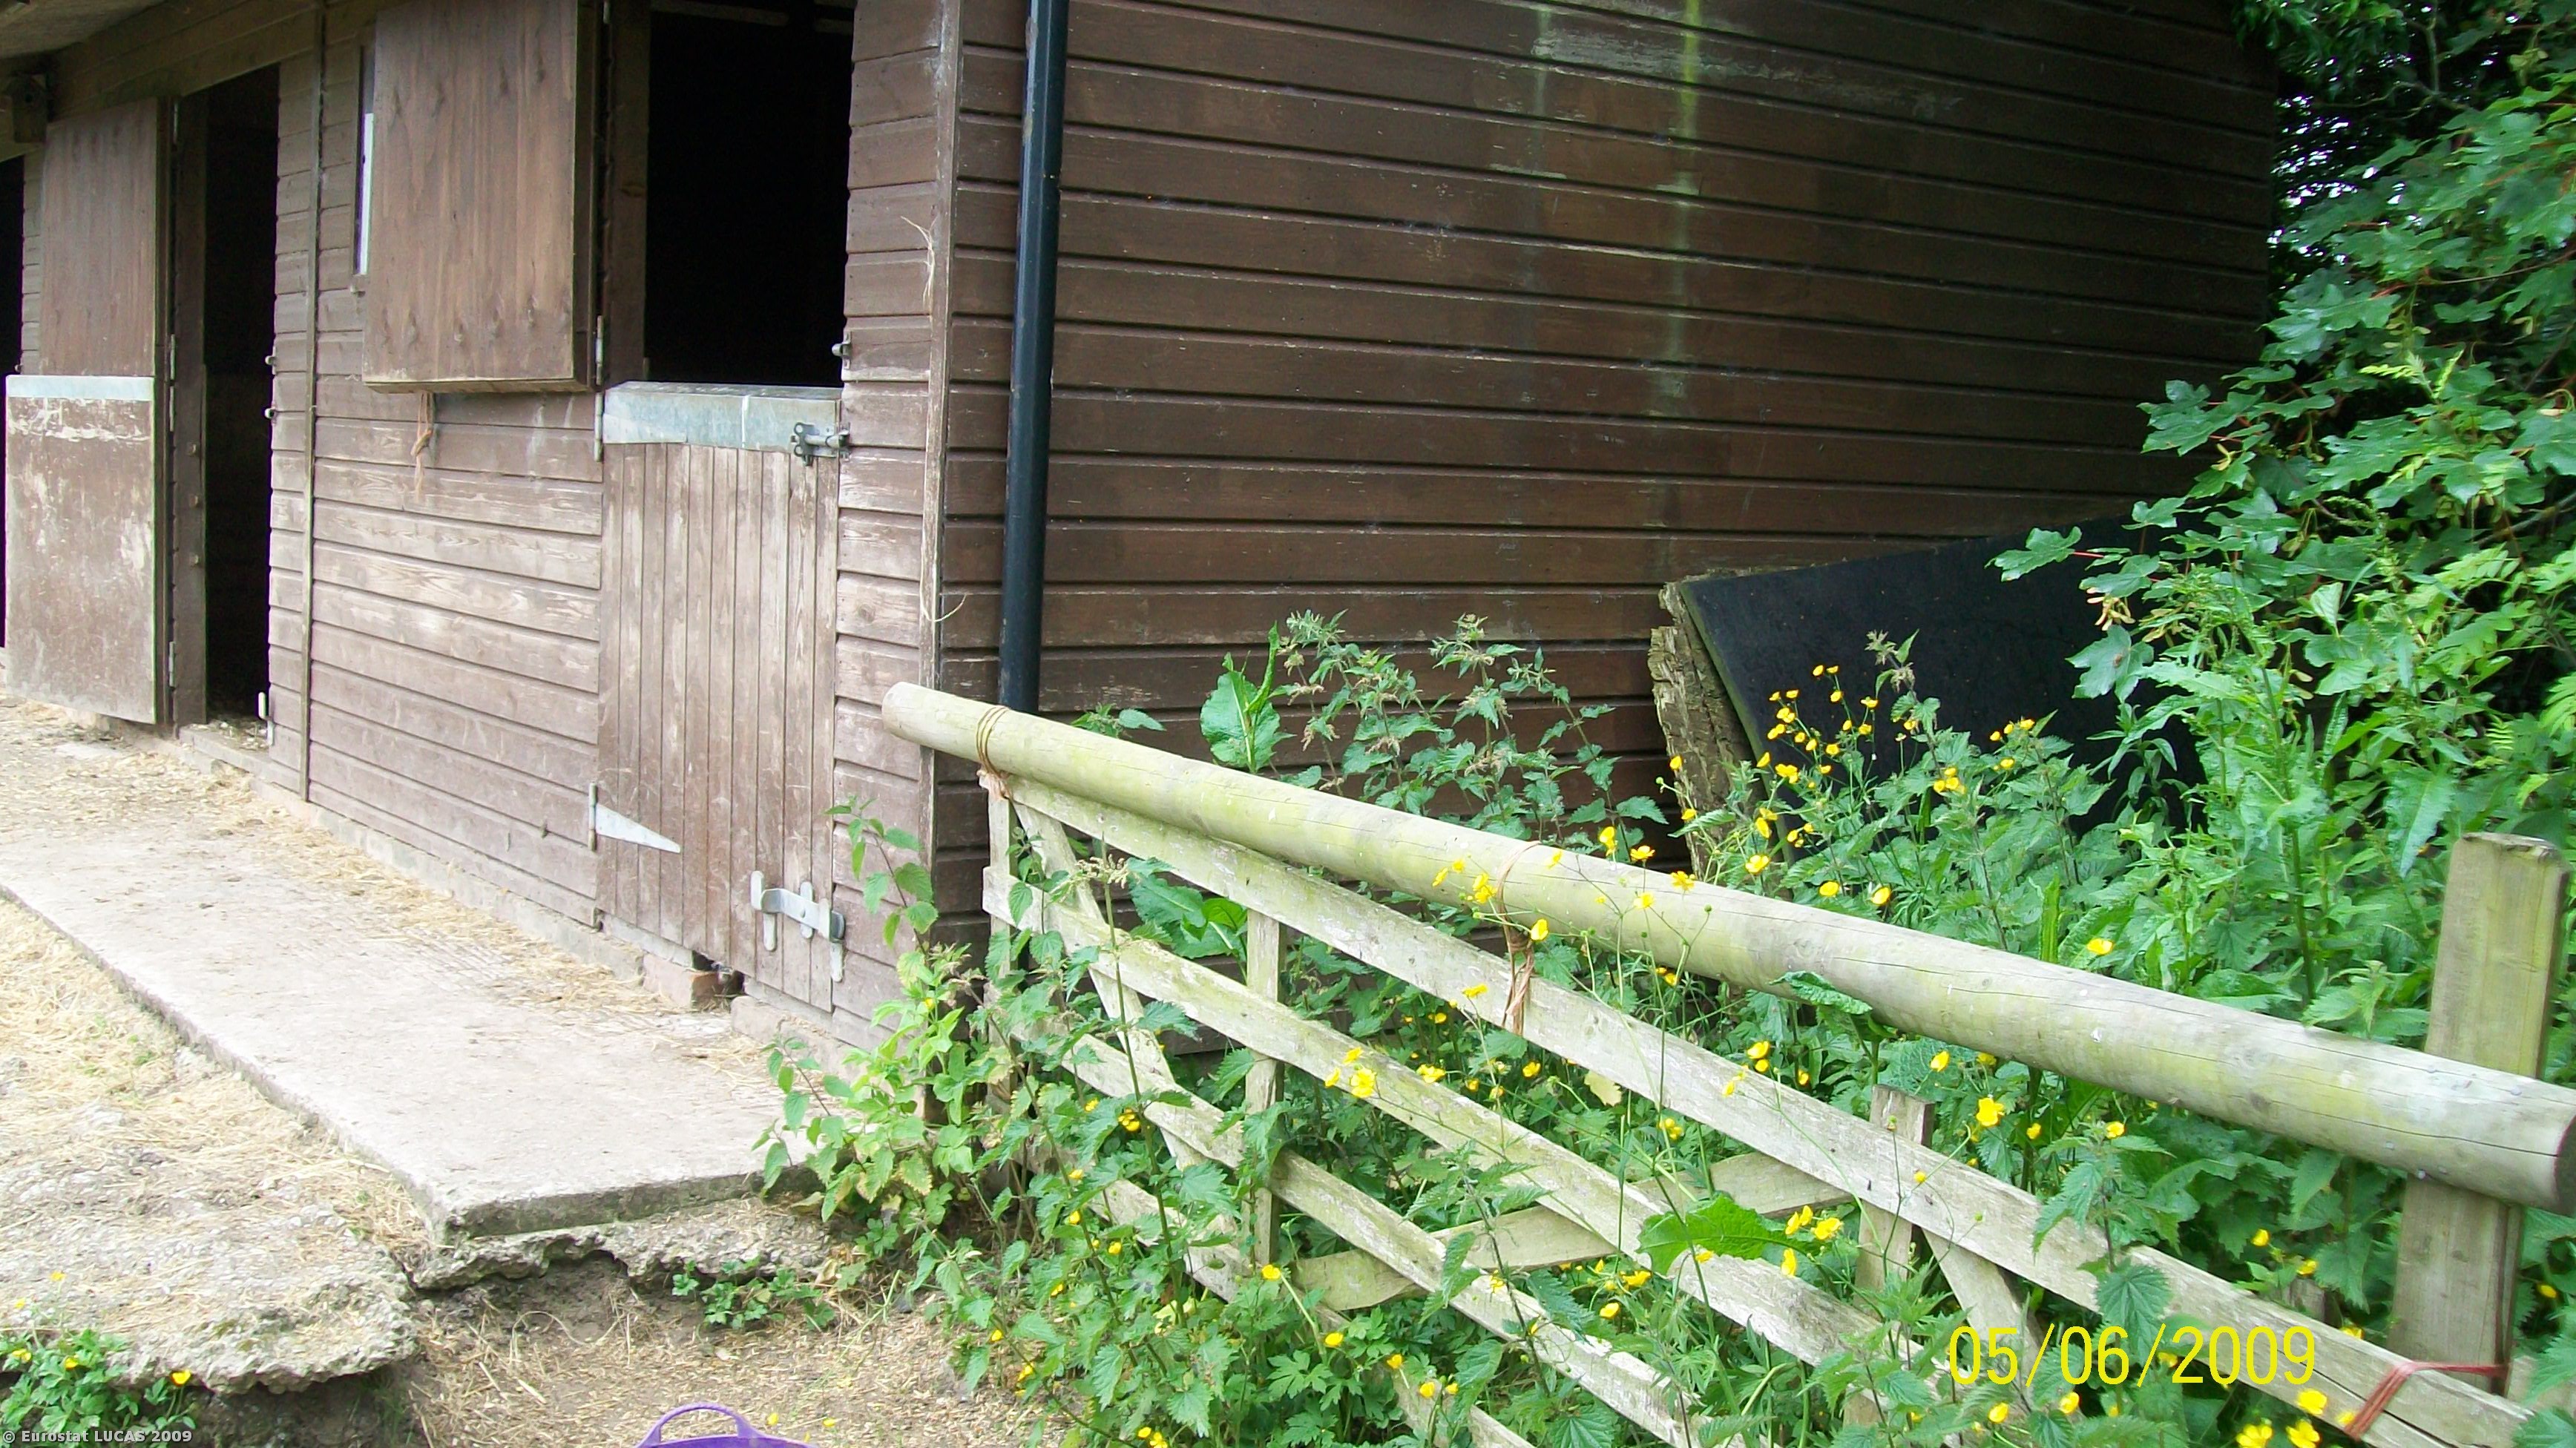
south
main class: Grassland
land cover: Grassland without tree/shrub cover
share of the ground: > 75 %
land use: Fallow land
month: June
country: GB
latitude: 53.0984
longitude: -2.6584
